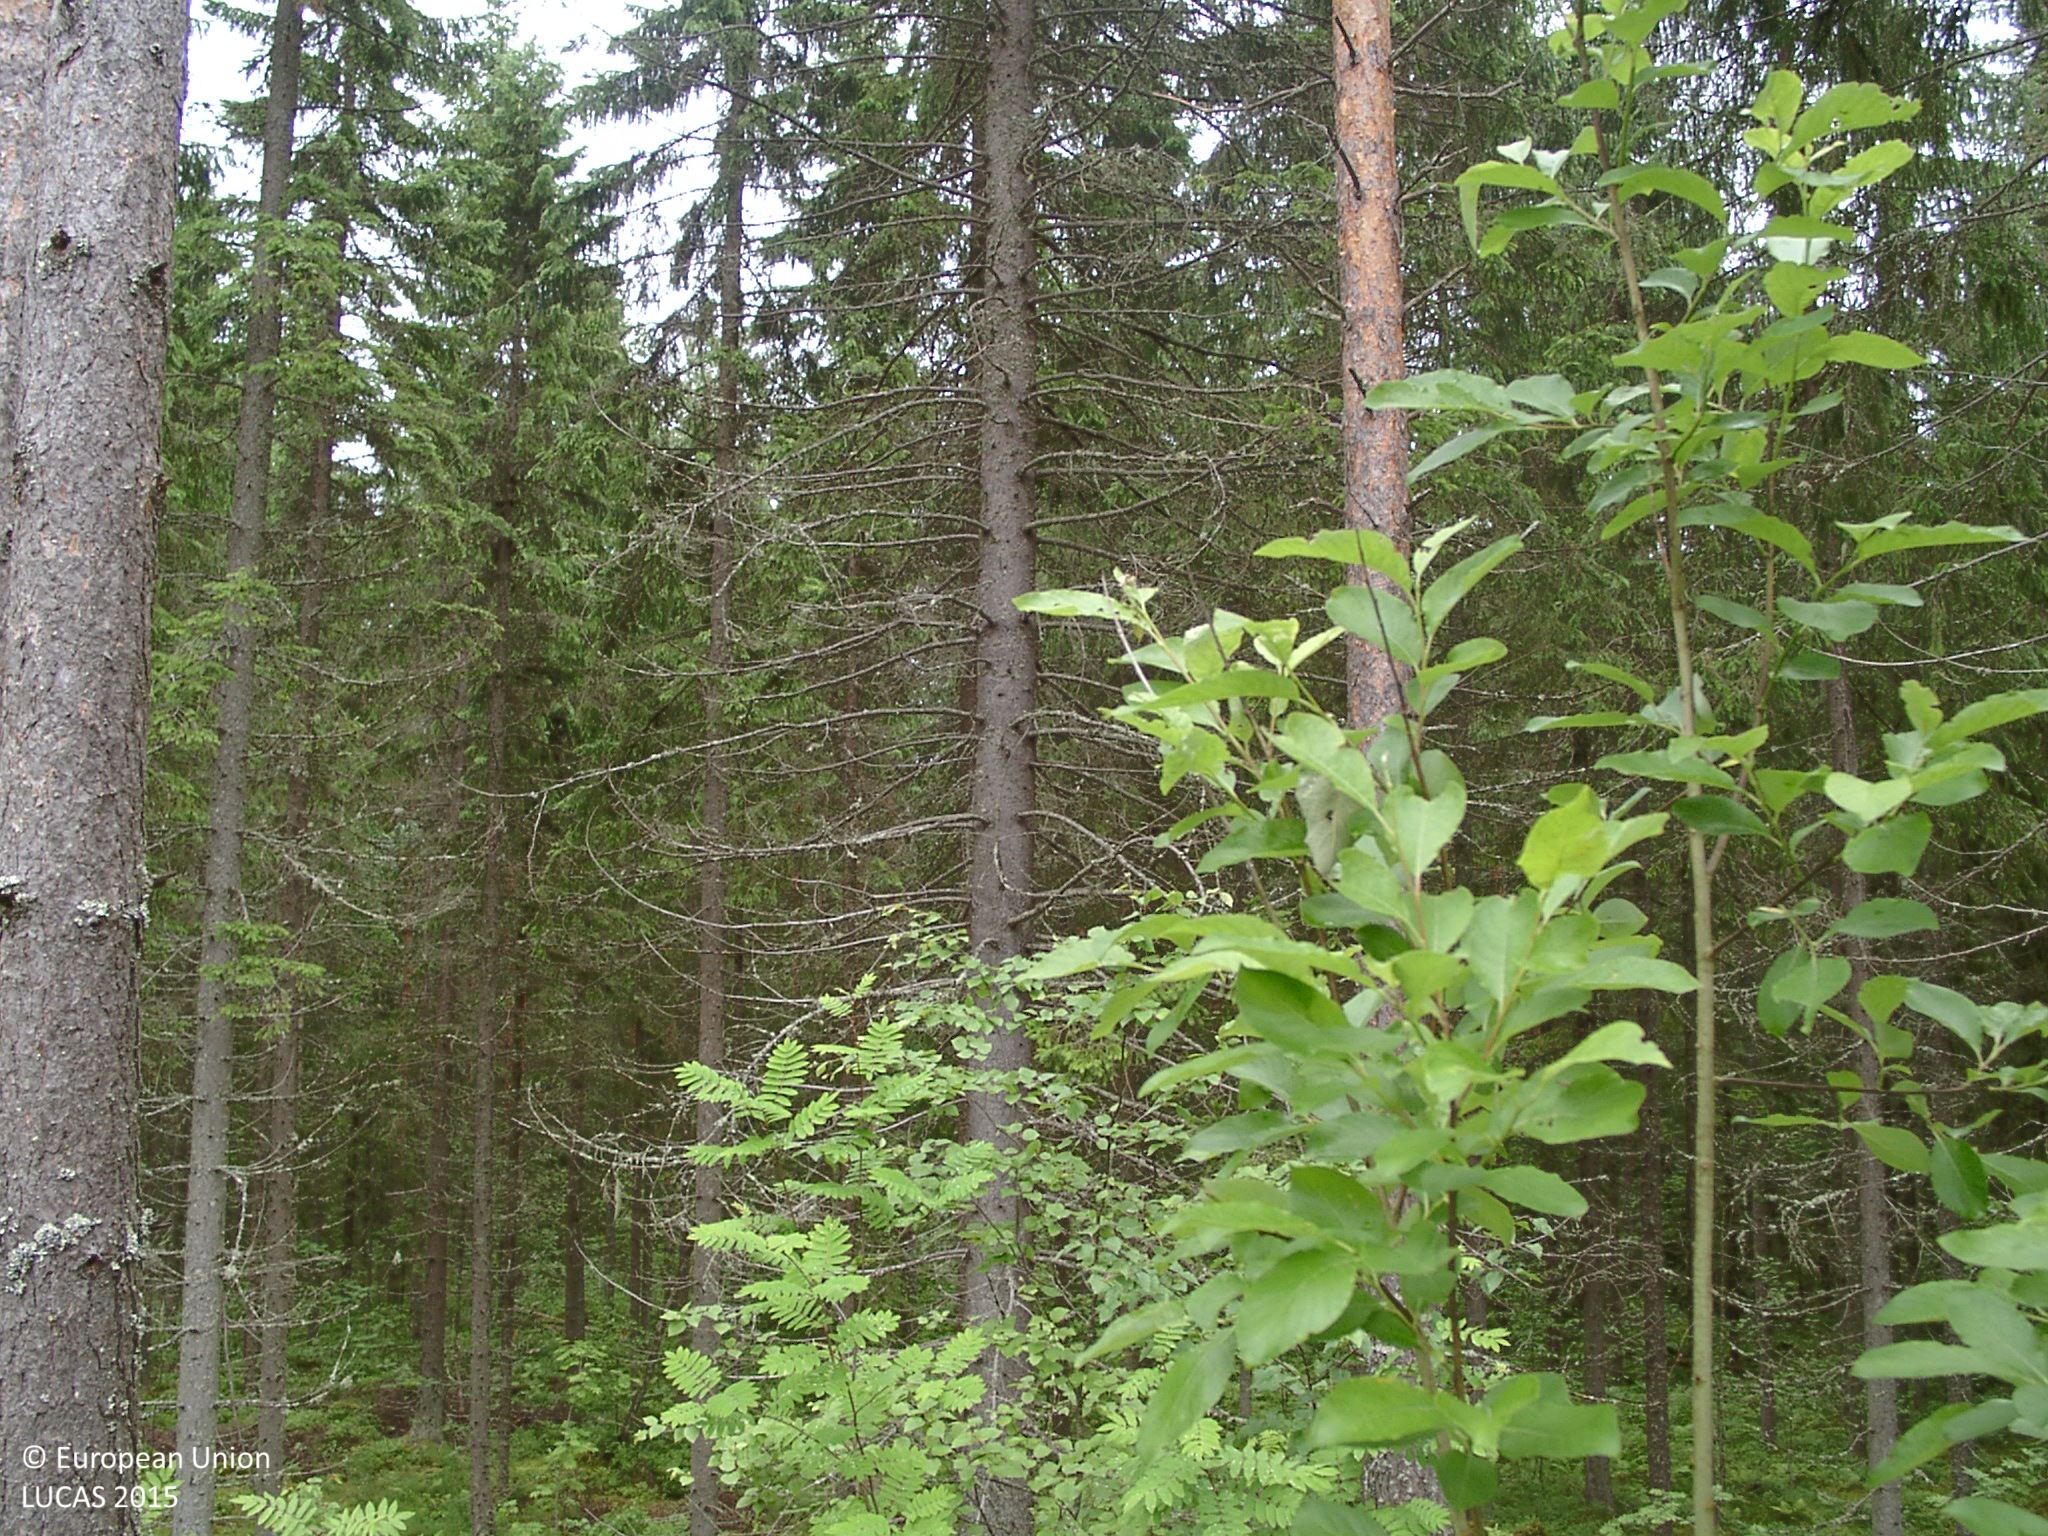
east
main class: Woodland
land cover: Other coniferous woodland
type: boreal forest
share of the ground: 50 - 75 %
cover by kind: coniferous forest trees 65 %, shrubs 10 %, herbaceous plants 10 %, broadleaved forest trees 5 %, lichens and mosses 5 %
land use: Forestry
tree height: > 5 m
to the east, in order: Other coniferous woodland; Shruby margins; Other coniferous woodland; Shruby margins; Other coniferous woodland; Spruce dominated mixed woodland; Shruby margins; Other mixed woodland; Shruby margins; Other mixed woodland; Shruby margins; Spruce dominated mixed woodland
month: July
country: FI
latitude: 62.0587
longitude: 25.5166
